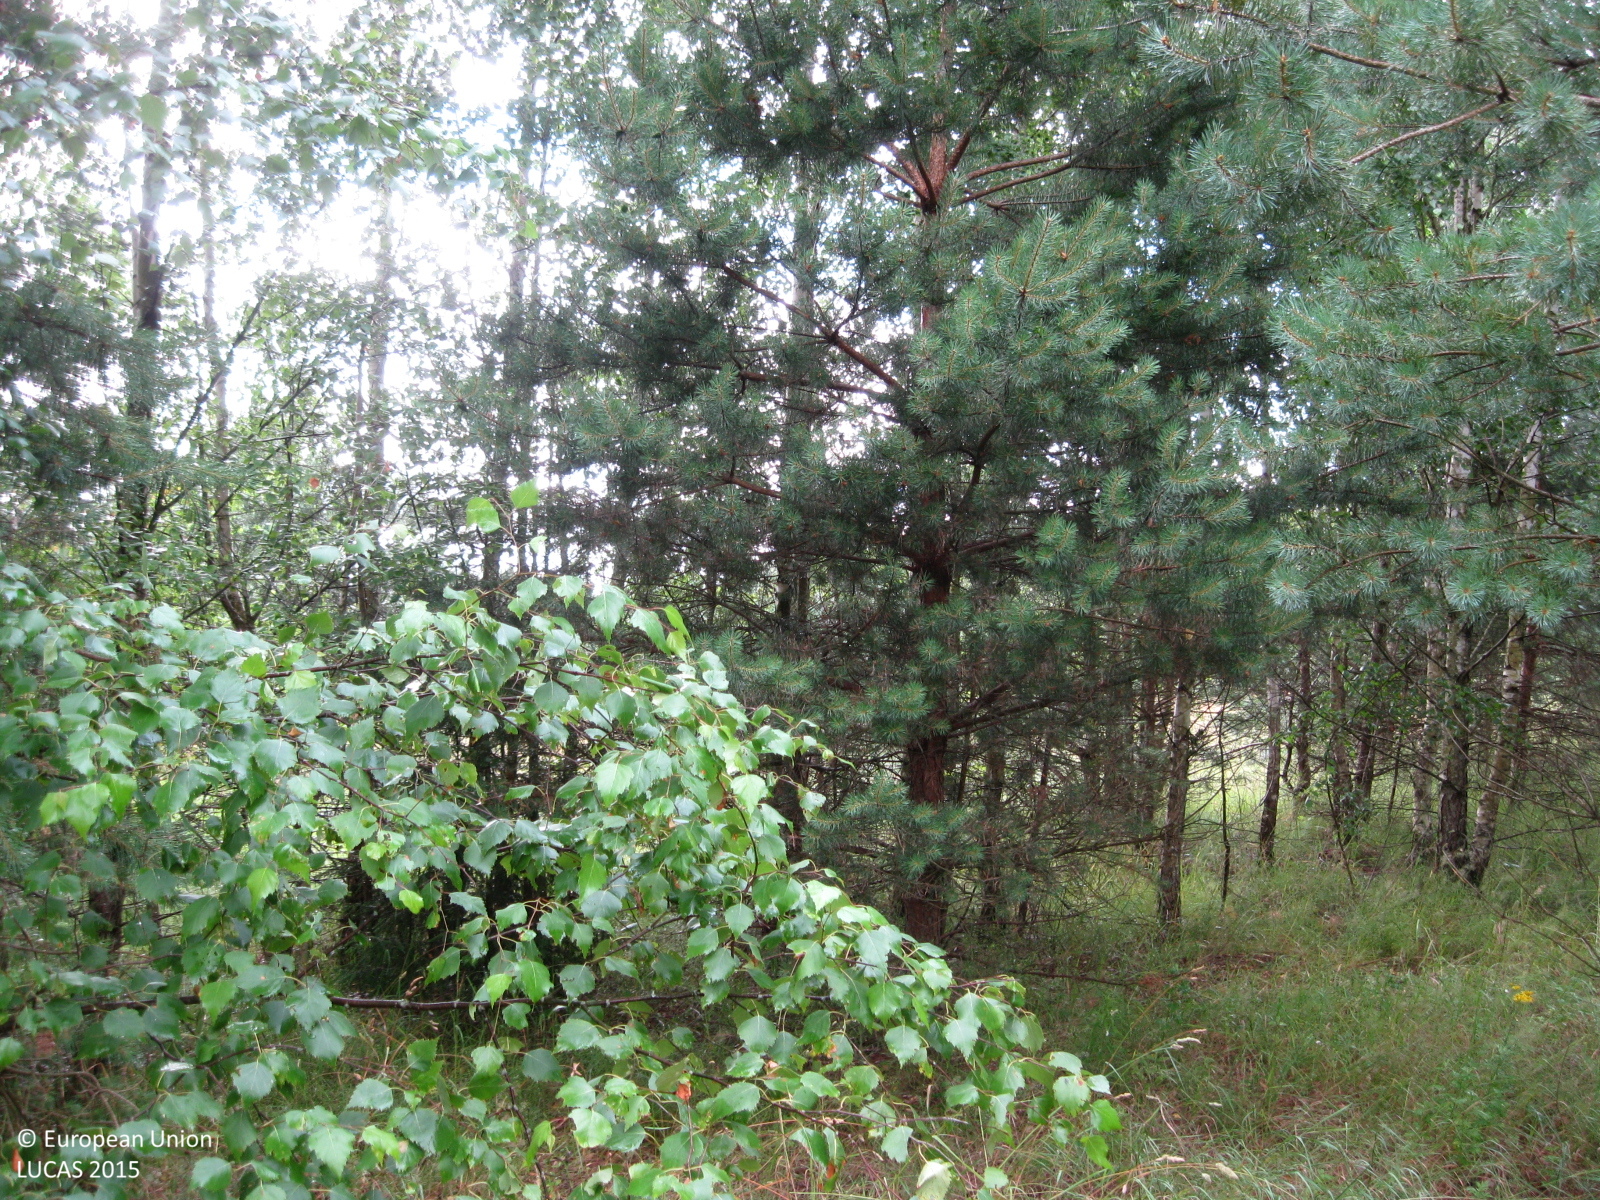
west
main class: Woodland
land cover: Pine dominated mixed woodland
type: hemiboreal forest and nemoral coniferous forest and mixed broadleaved-coniferous forest
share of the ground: 50 - 75 %
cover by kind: herbaceous plants 45 %, coniferous forest trees 35 %, broadleaved forest trees 20 %
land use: Forestry
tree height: > 5 m
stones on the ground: < 10 %
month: July
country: LT
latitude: 55.7503
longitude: 24.7463
